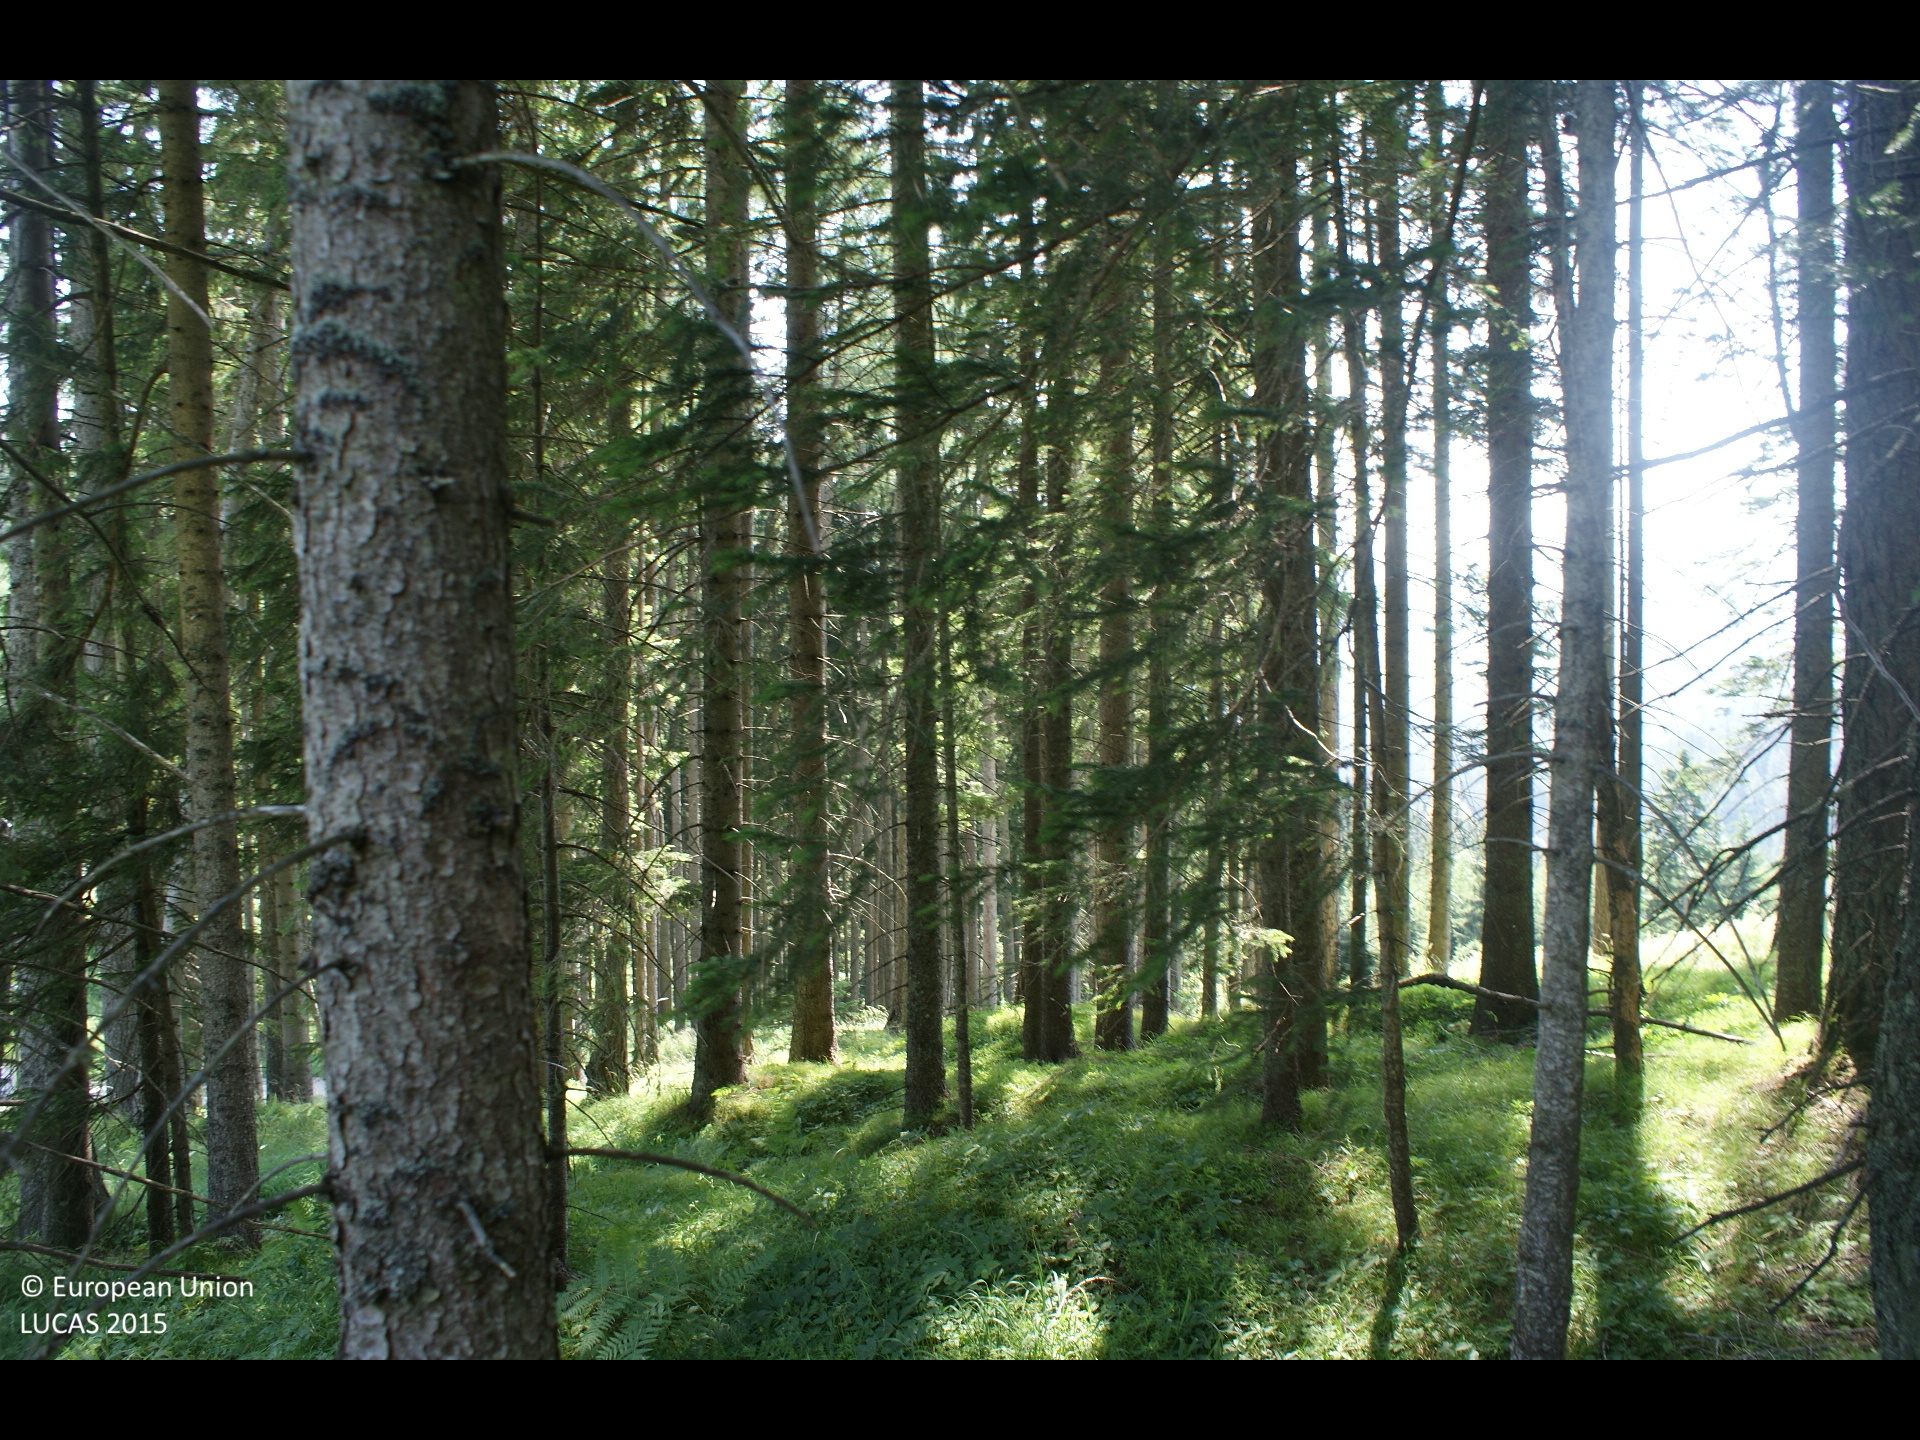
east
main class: Woodland
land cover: Spruce dominated coniferous woodland
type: alpine coniferous forest
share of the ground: > 75 %
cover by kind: coniferous forest trees 100 %
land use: Forestry
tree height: > 5 m
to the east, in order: Spruce dominated coniferous woodland; Tracks; Spruce dominated coniferous woodland; Grassland without tree/shrub cover; Tracks; Grassland without tree/shrub cover; Spruce dominated coniferous woodland
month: July
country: AT
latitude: 47.8087
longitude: 15.2757
